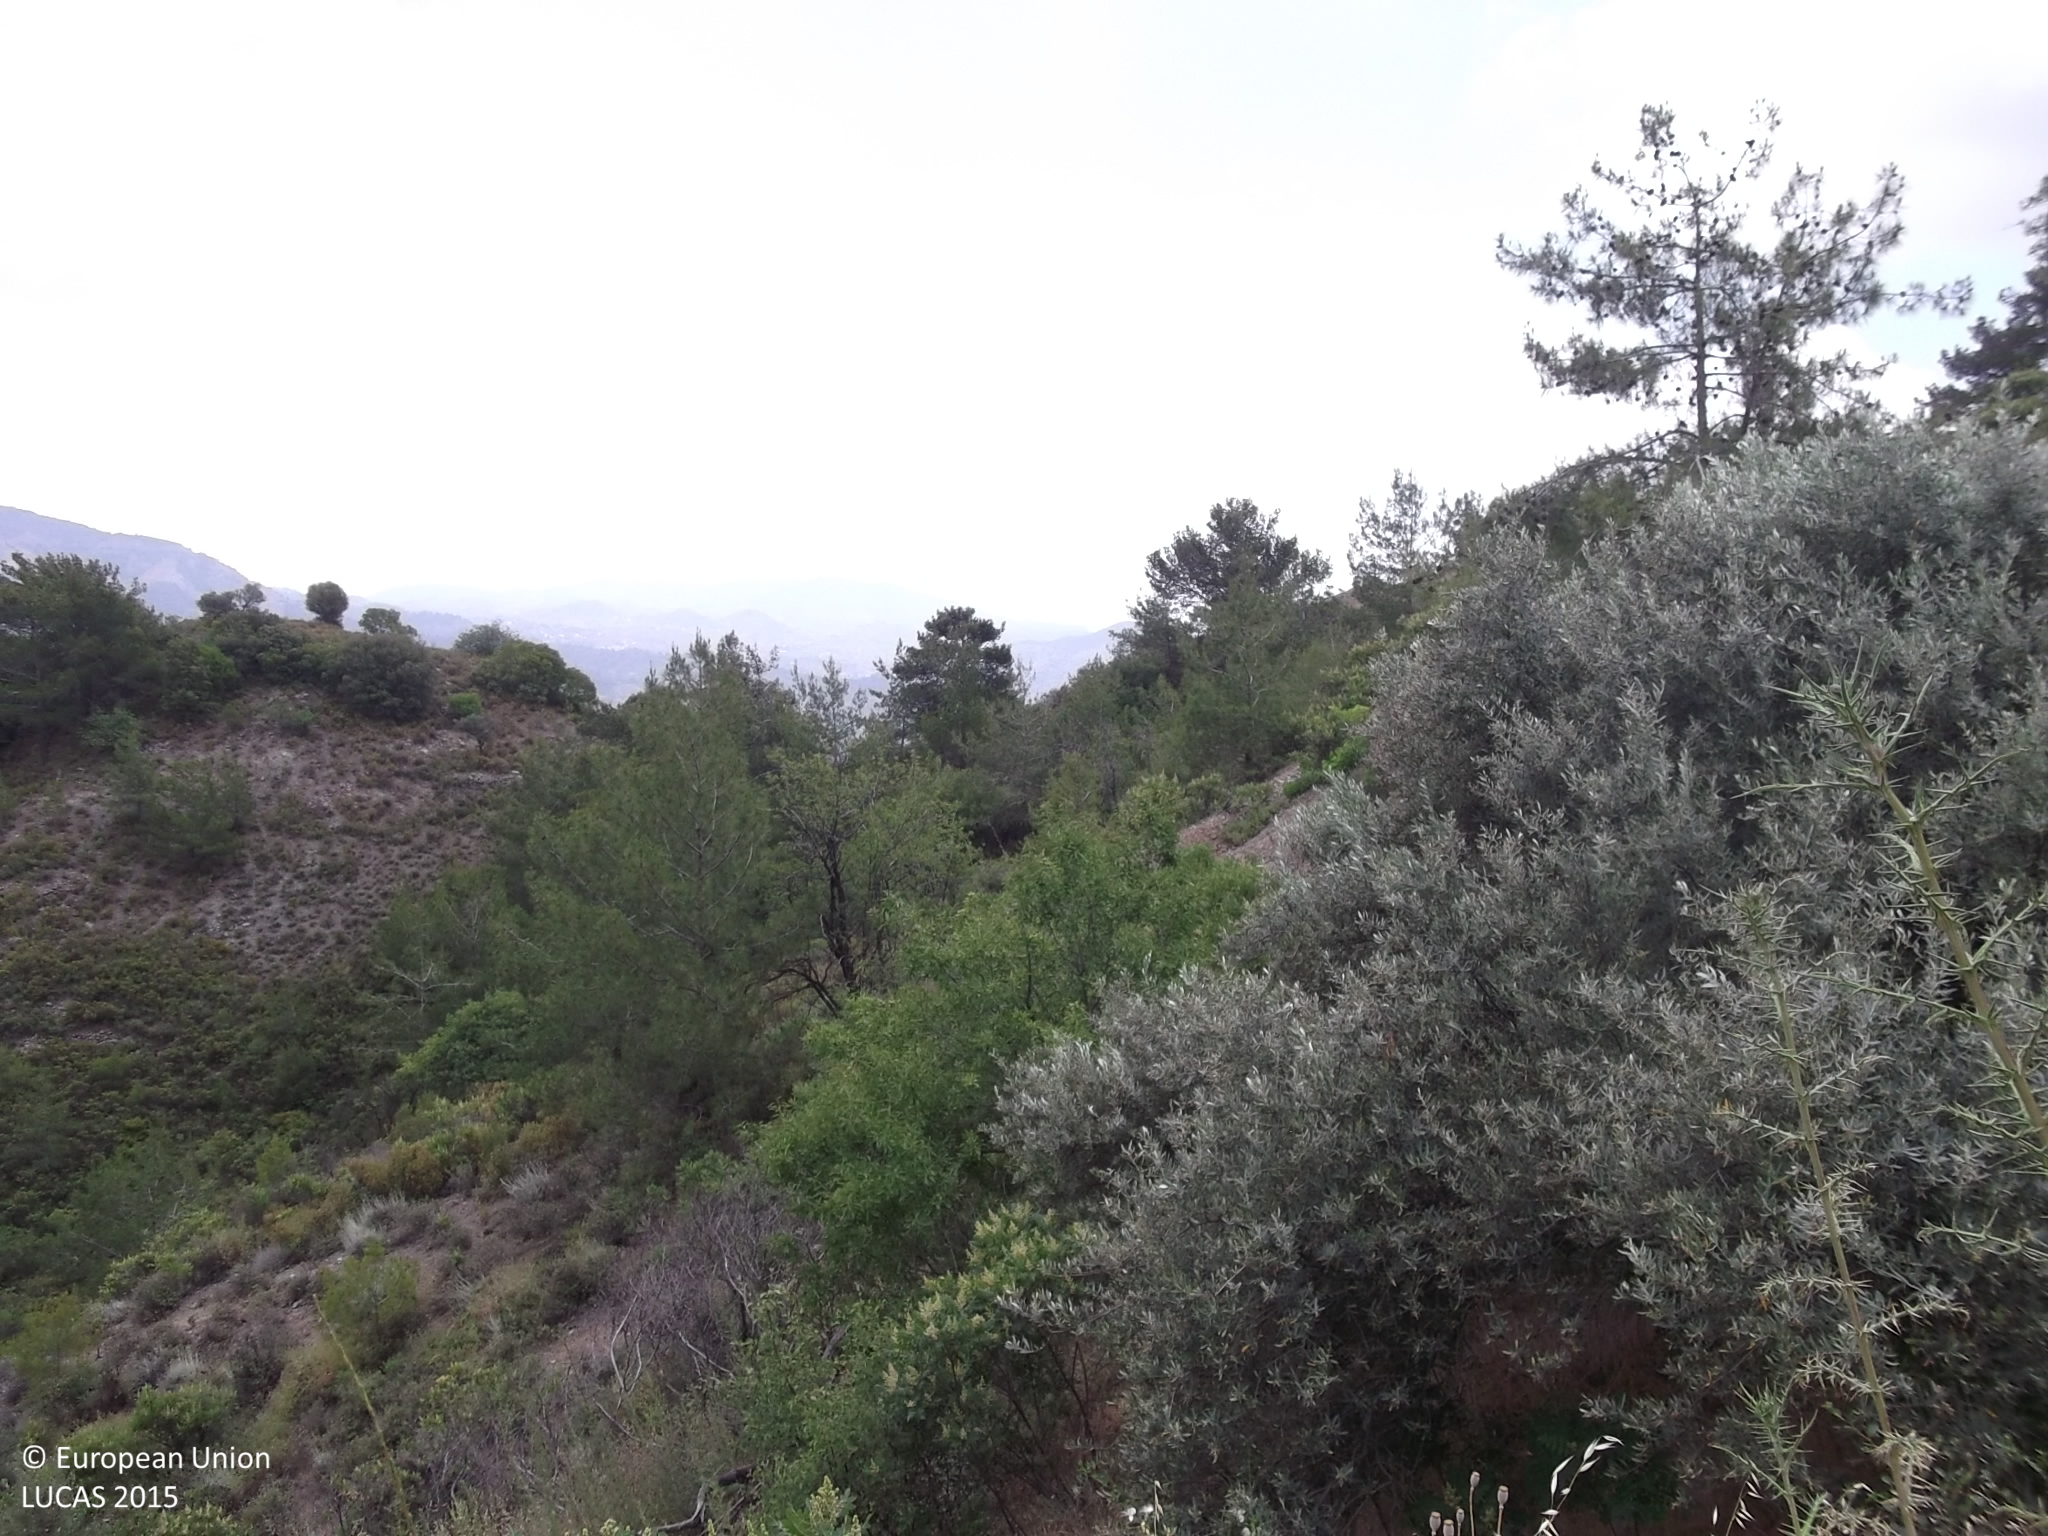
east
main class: Woodland
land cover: Pine dominated mixed woodland
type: coniferous forest of the mediterranean region
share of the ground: 25 - 50 %
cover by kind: coniferous forest trees 45 %, shrubs 25 %, broadleaved forest trees 15 %, consolidated bare surface 15 %
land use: Forestry
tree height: > 5 m
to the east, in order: Pine dominated mixed woodland; Pine dominated coniferous woodland; Tracks; Pine dominated coniferous woodland
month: June
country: CY
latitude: 34.8798
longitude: 32.9578
